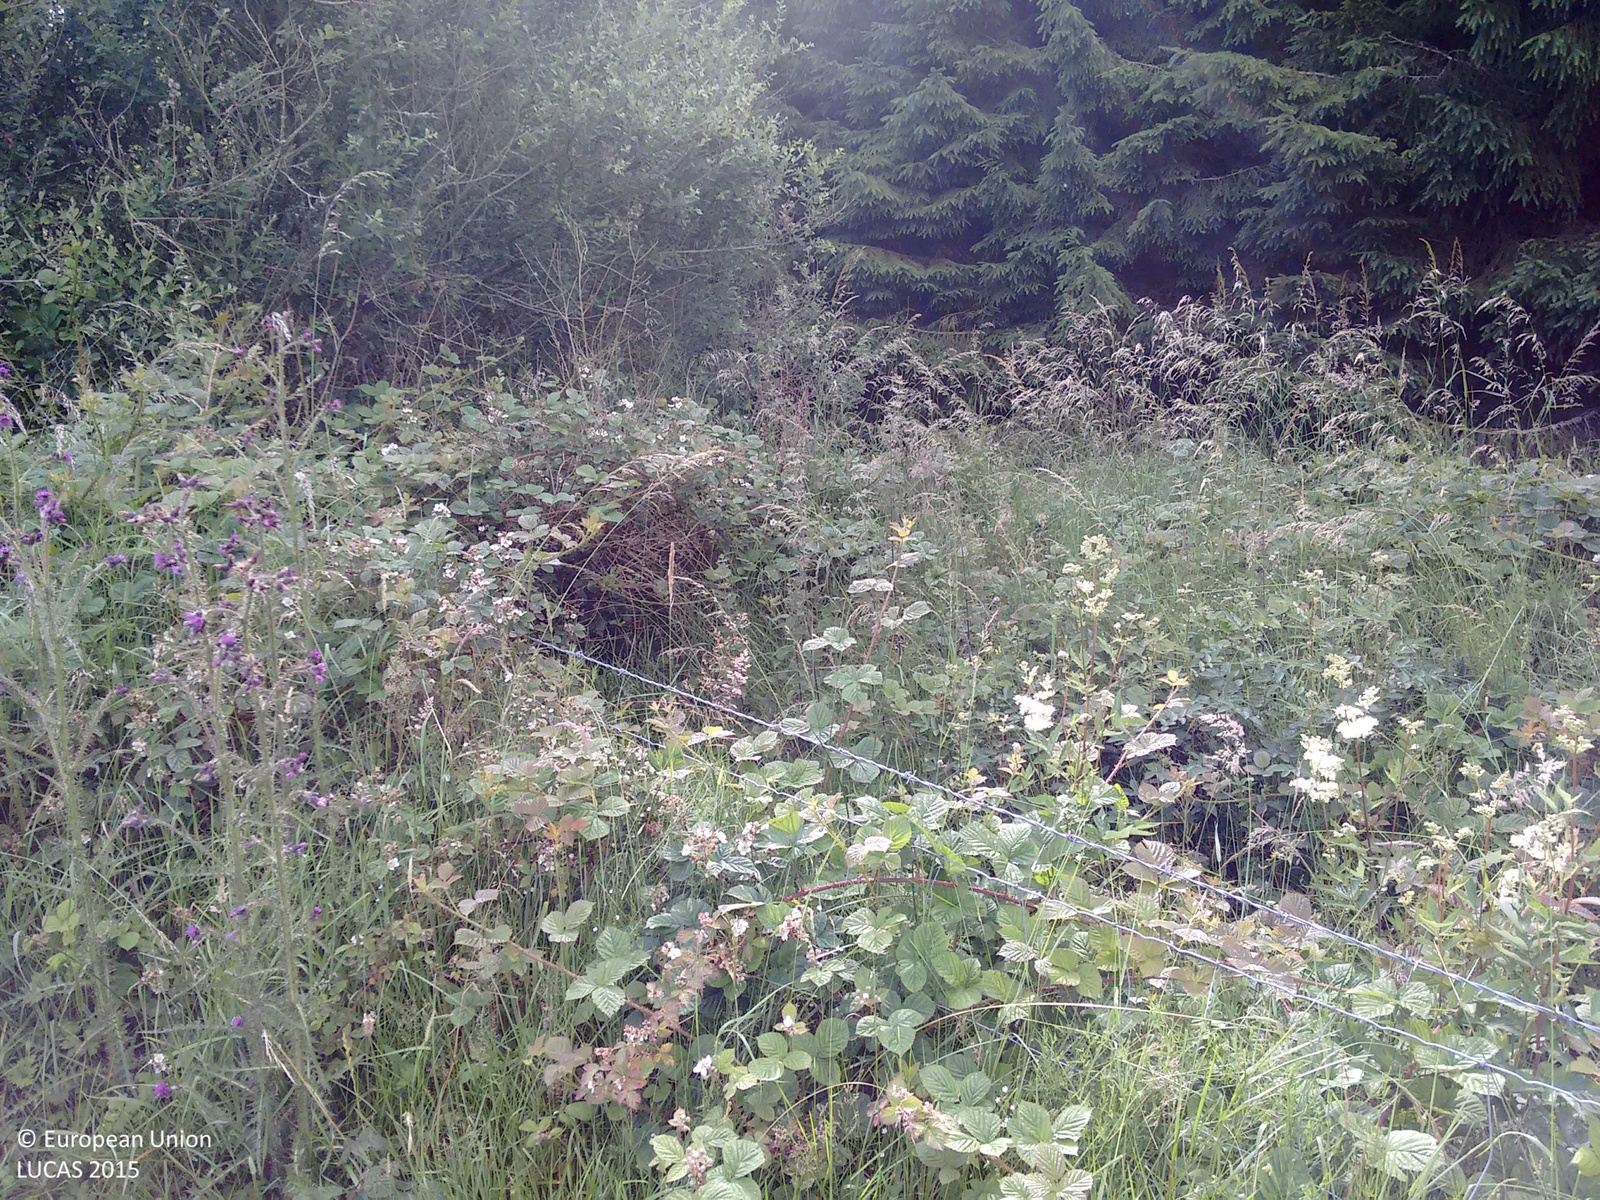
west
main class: Woodland
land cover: Pine dominated coniferous woodland
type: exotic forest
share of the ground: > 75 %
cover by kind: coniferous forest trees 90 %, broadleaved forest trees 5 %, shrubs 5 %
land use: Forestry
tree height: > 5 m
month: July
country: IE
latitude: 53.6240
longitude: -7.7504
